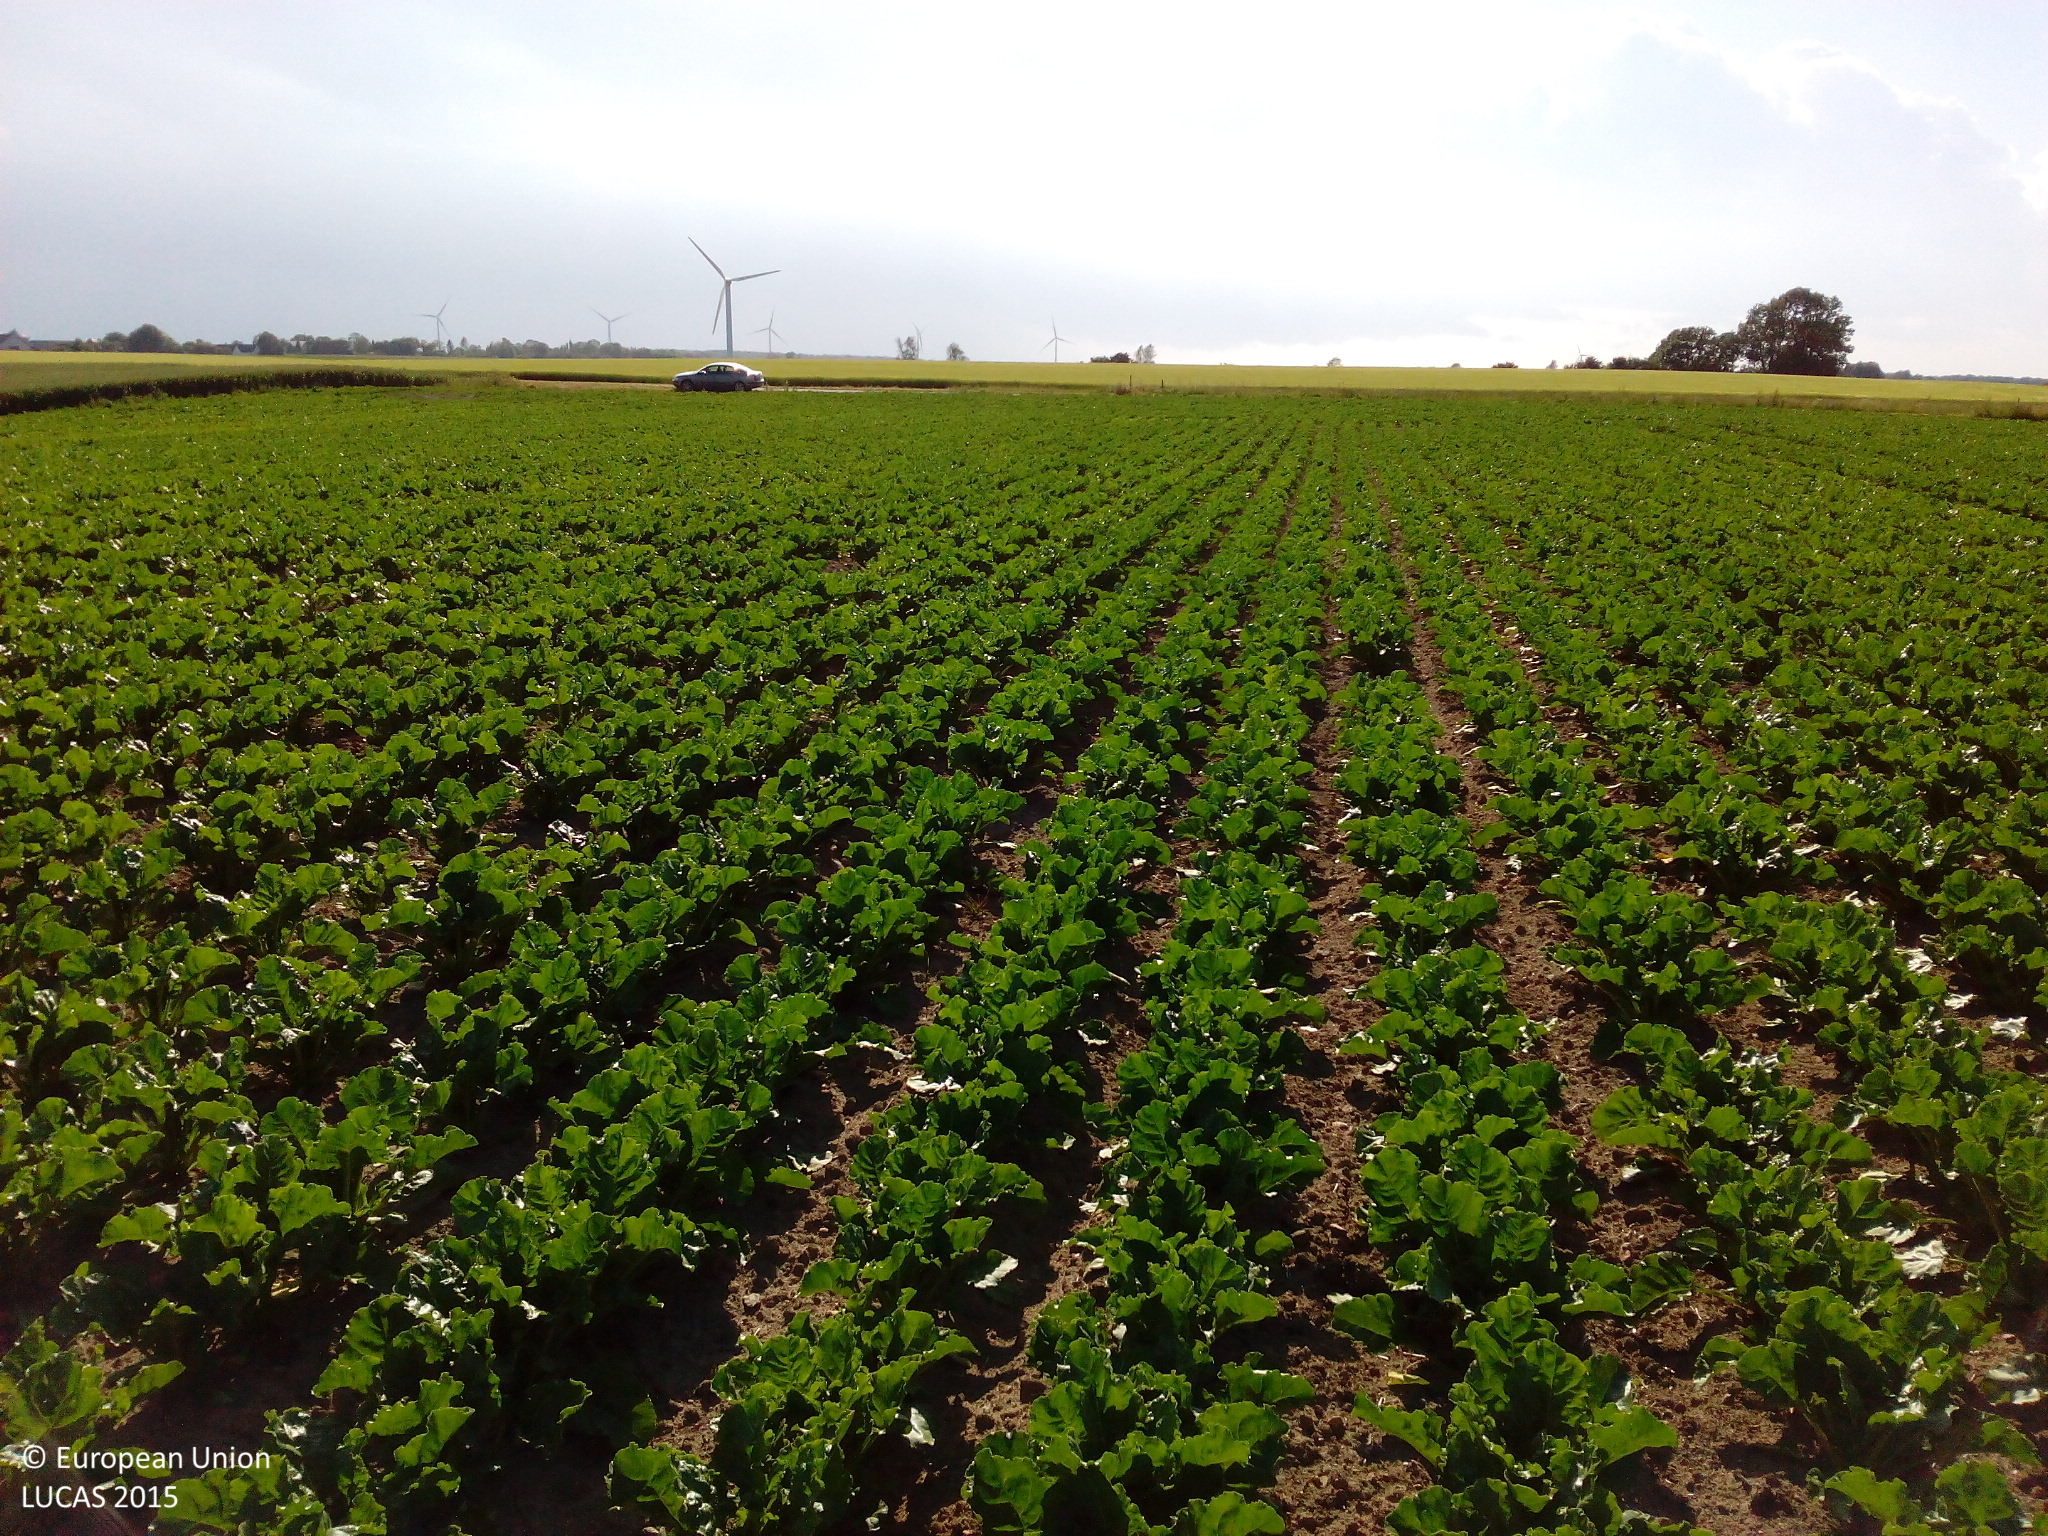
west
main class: Cropland
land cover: Sugar beet
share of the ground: > 75 %
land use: Agriculture (excluding fallow land and kitchen gardens)
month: June
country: DK
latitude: 54.9415
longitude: 11.2323
